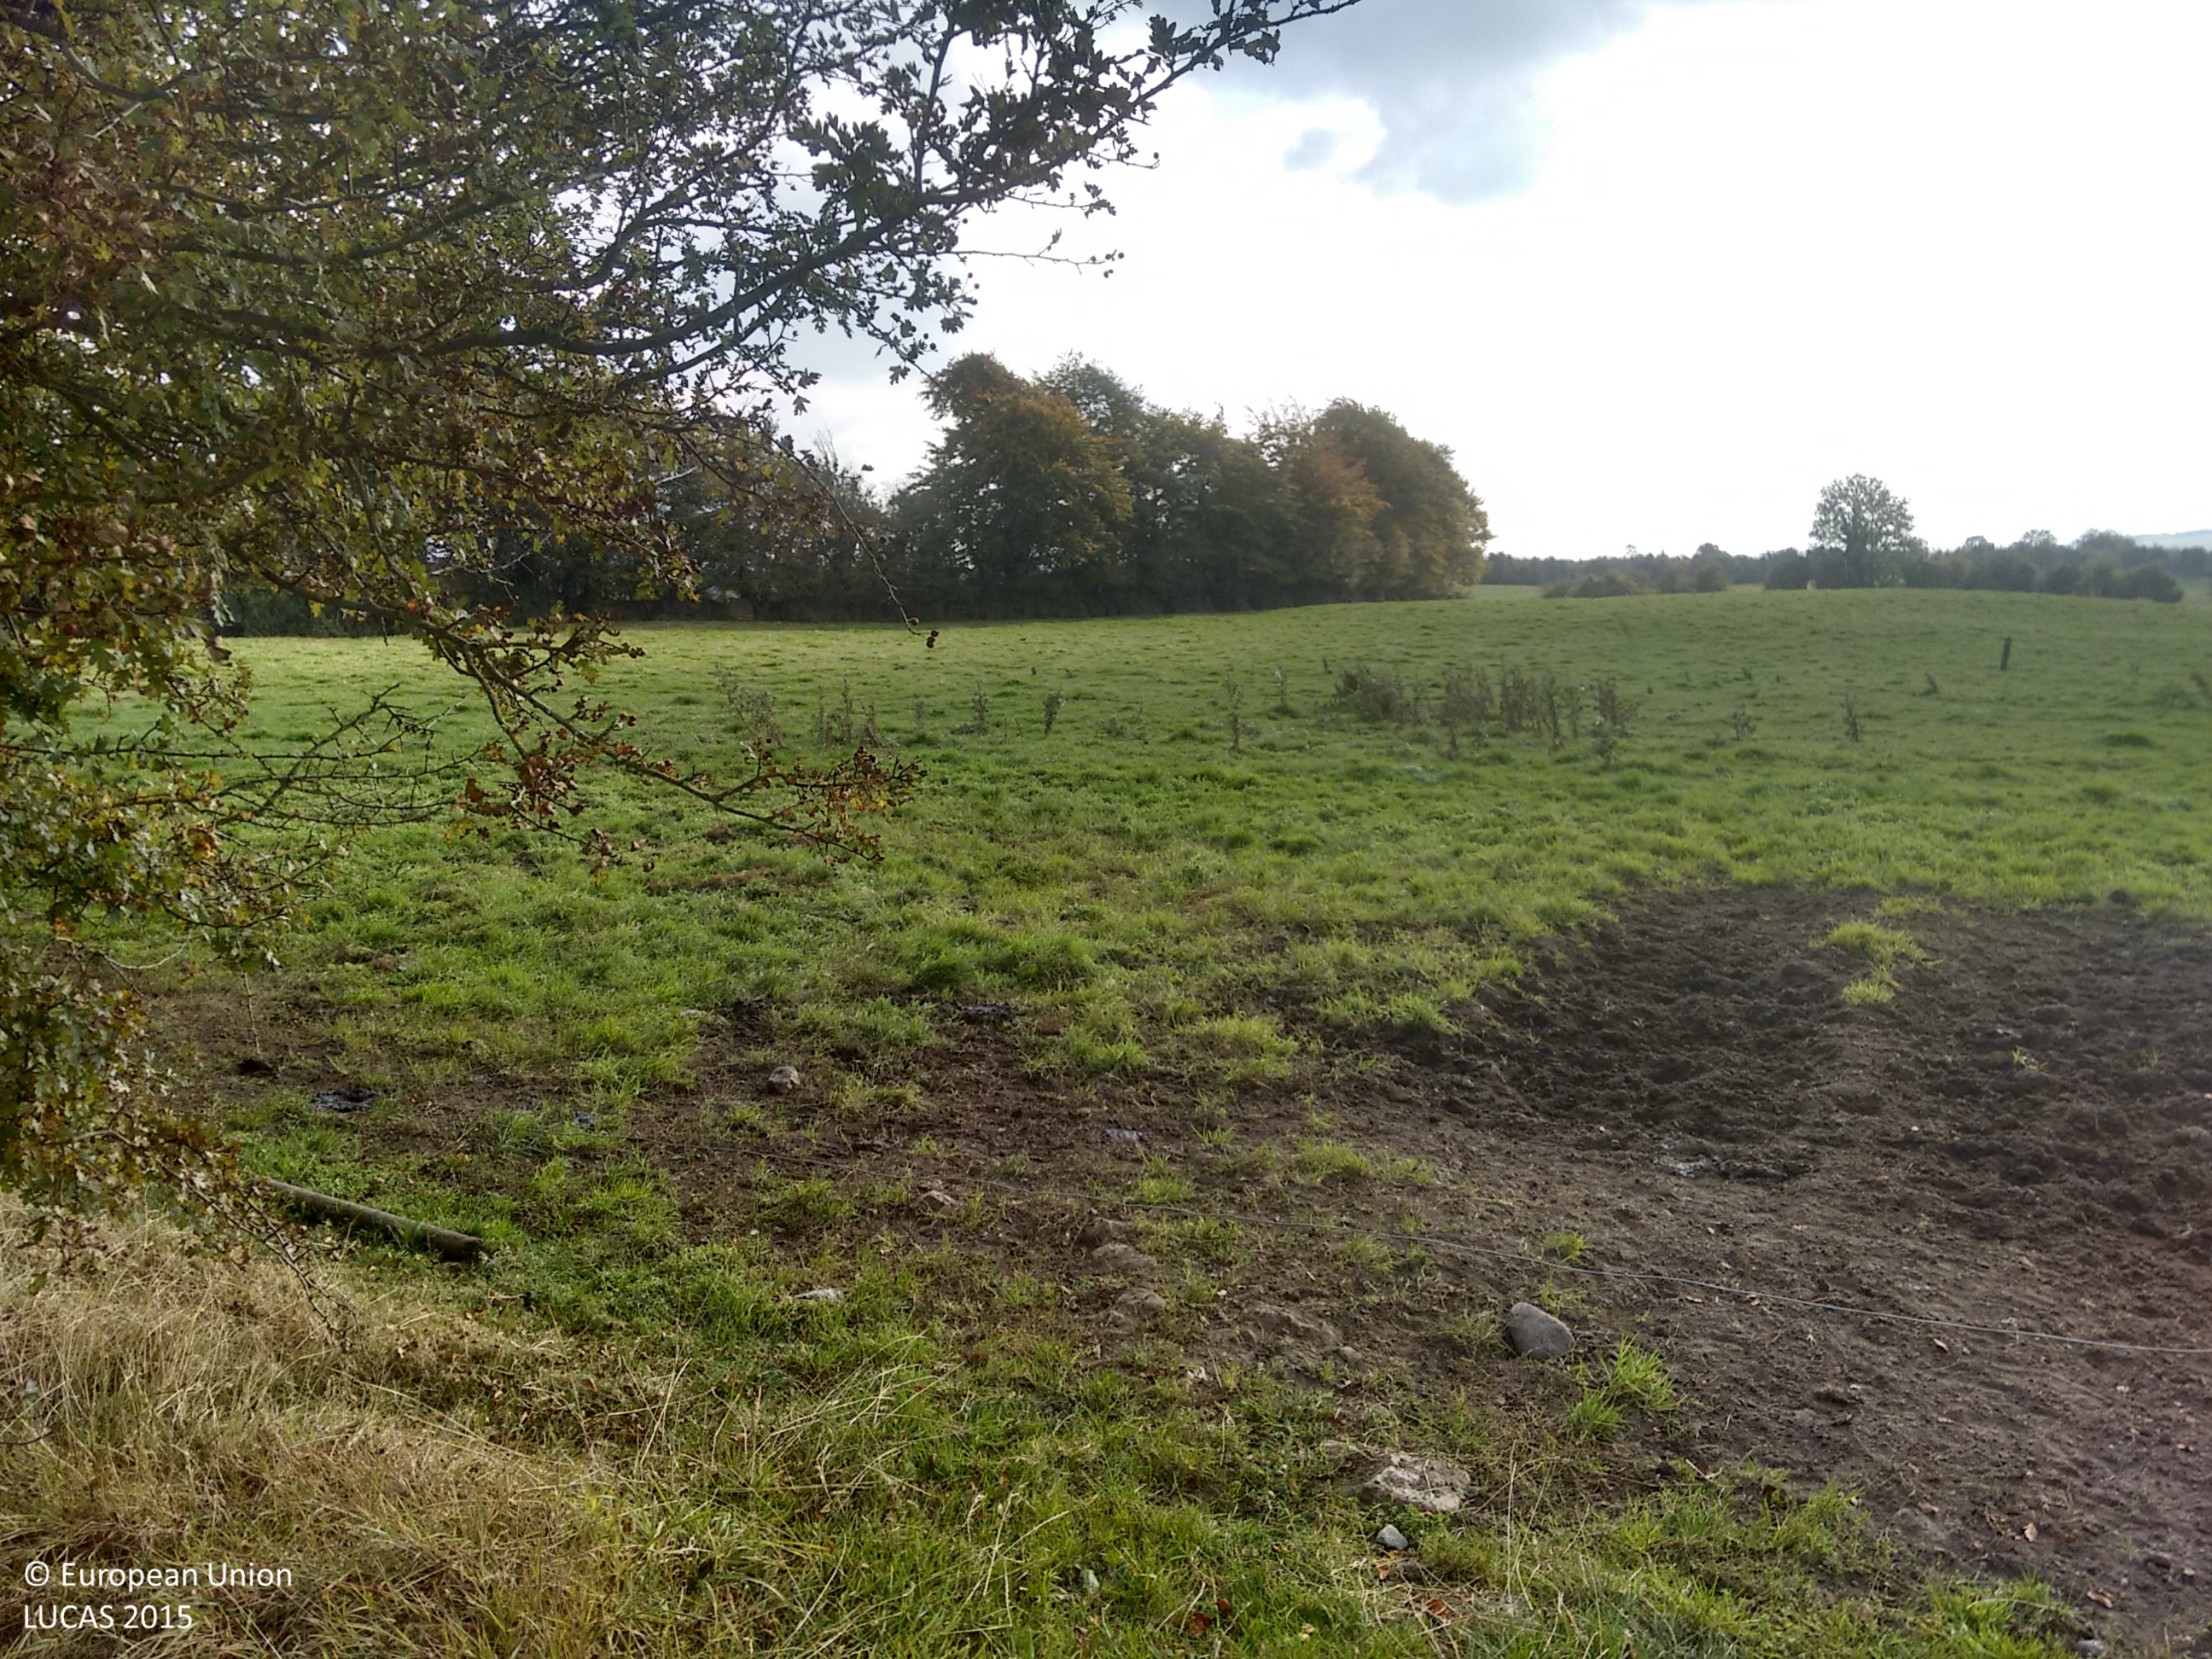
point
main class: Grassland
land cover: Grassland without tree/shrub cover
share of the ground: > 75 %
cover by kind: herbaceous plants 100 %
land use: Agriculture (excluding fallow land and kitchen gardens)
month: October
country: IE
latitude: 52.8343
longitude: -7.6036
